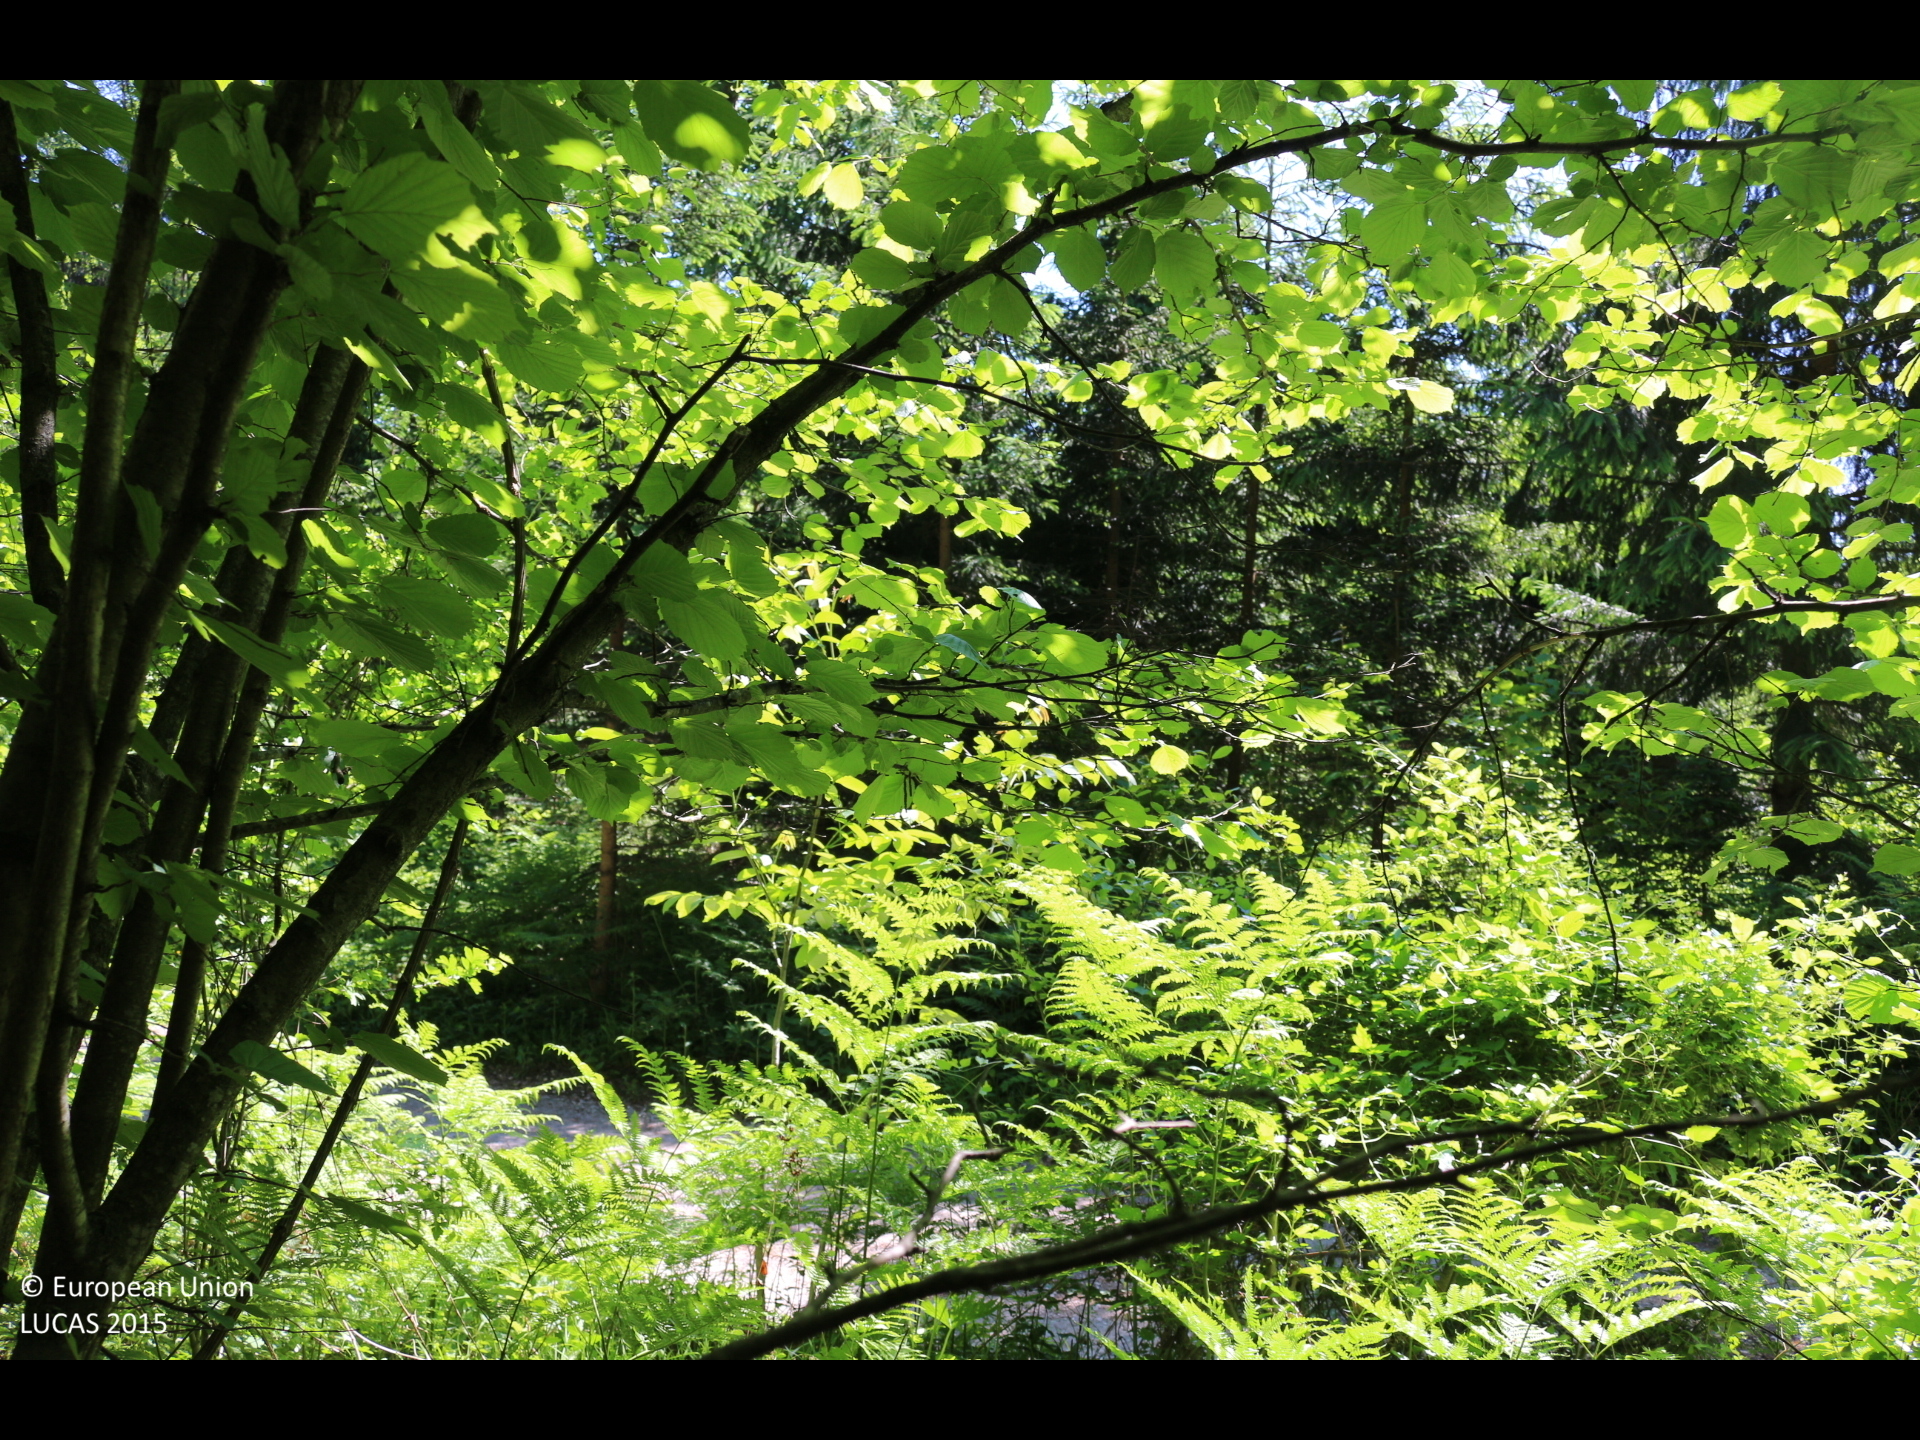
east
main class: Woodland
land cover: Spruce dominated mixed woodland
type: alpine coniferous forest
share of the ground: > 75 %
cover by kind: coniferous forest trees 70 %, broadleaved forest trees 30 %
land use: Forestry
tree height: > 5 m
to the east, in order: Spruce dominated mixed woodland; Tracks; Spruce dominated coniferous woodland; Shrubland with sparse tree cover; Tracks; Shrubland with sparse tree cover; Spruce dominated mixed woodland
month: May
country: AT
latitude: 46.5240
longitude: 14.1296
